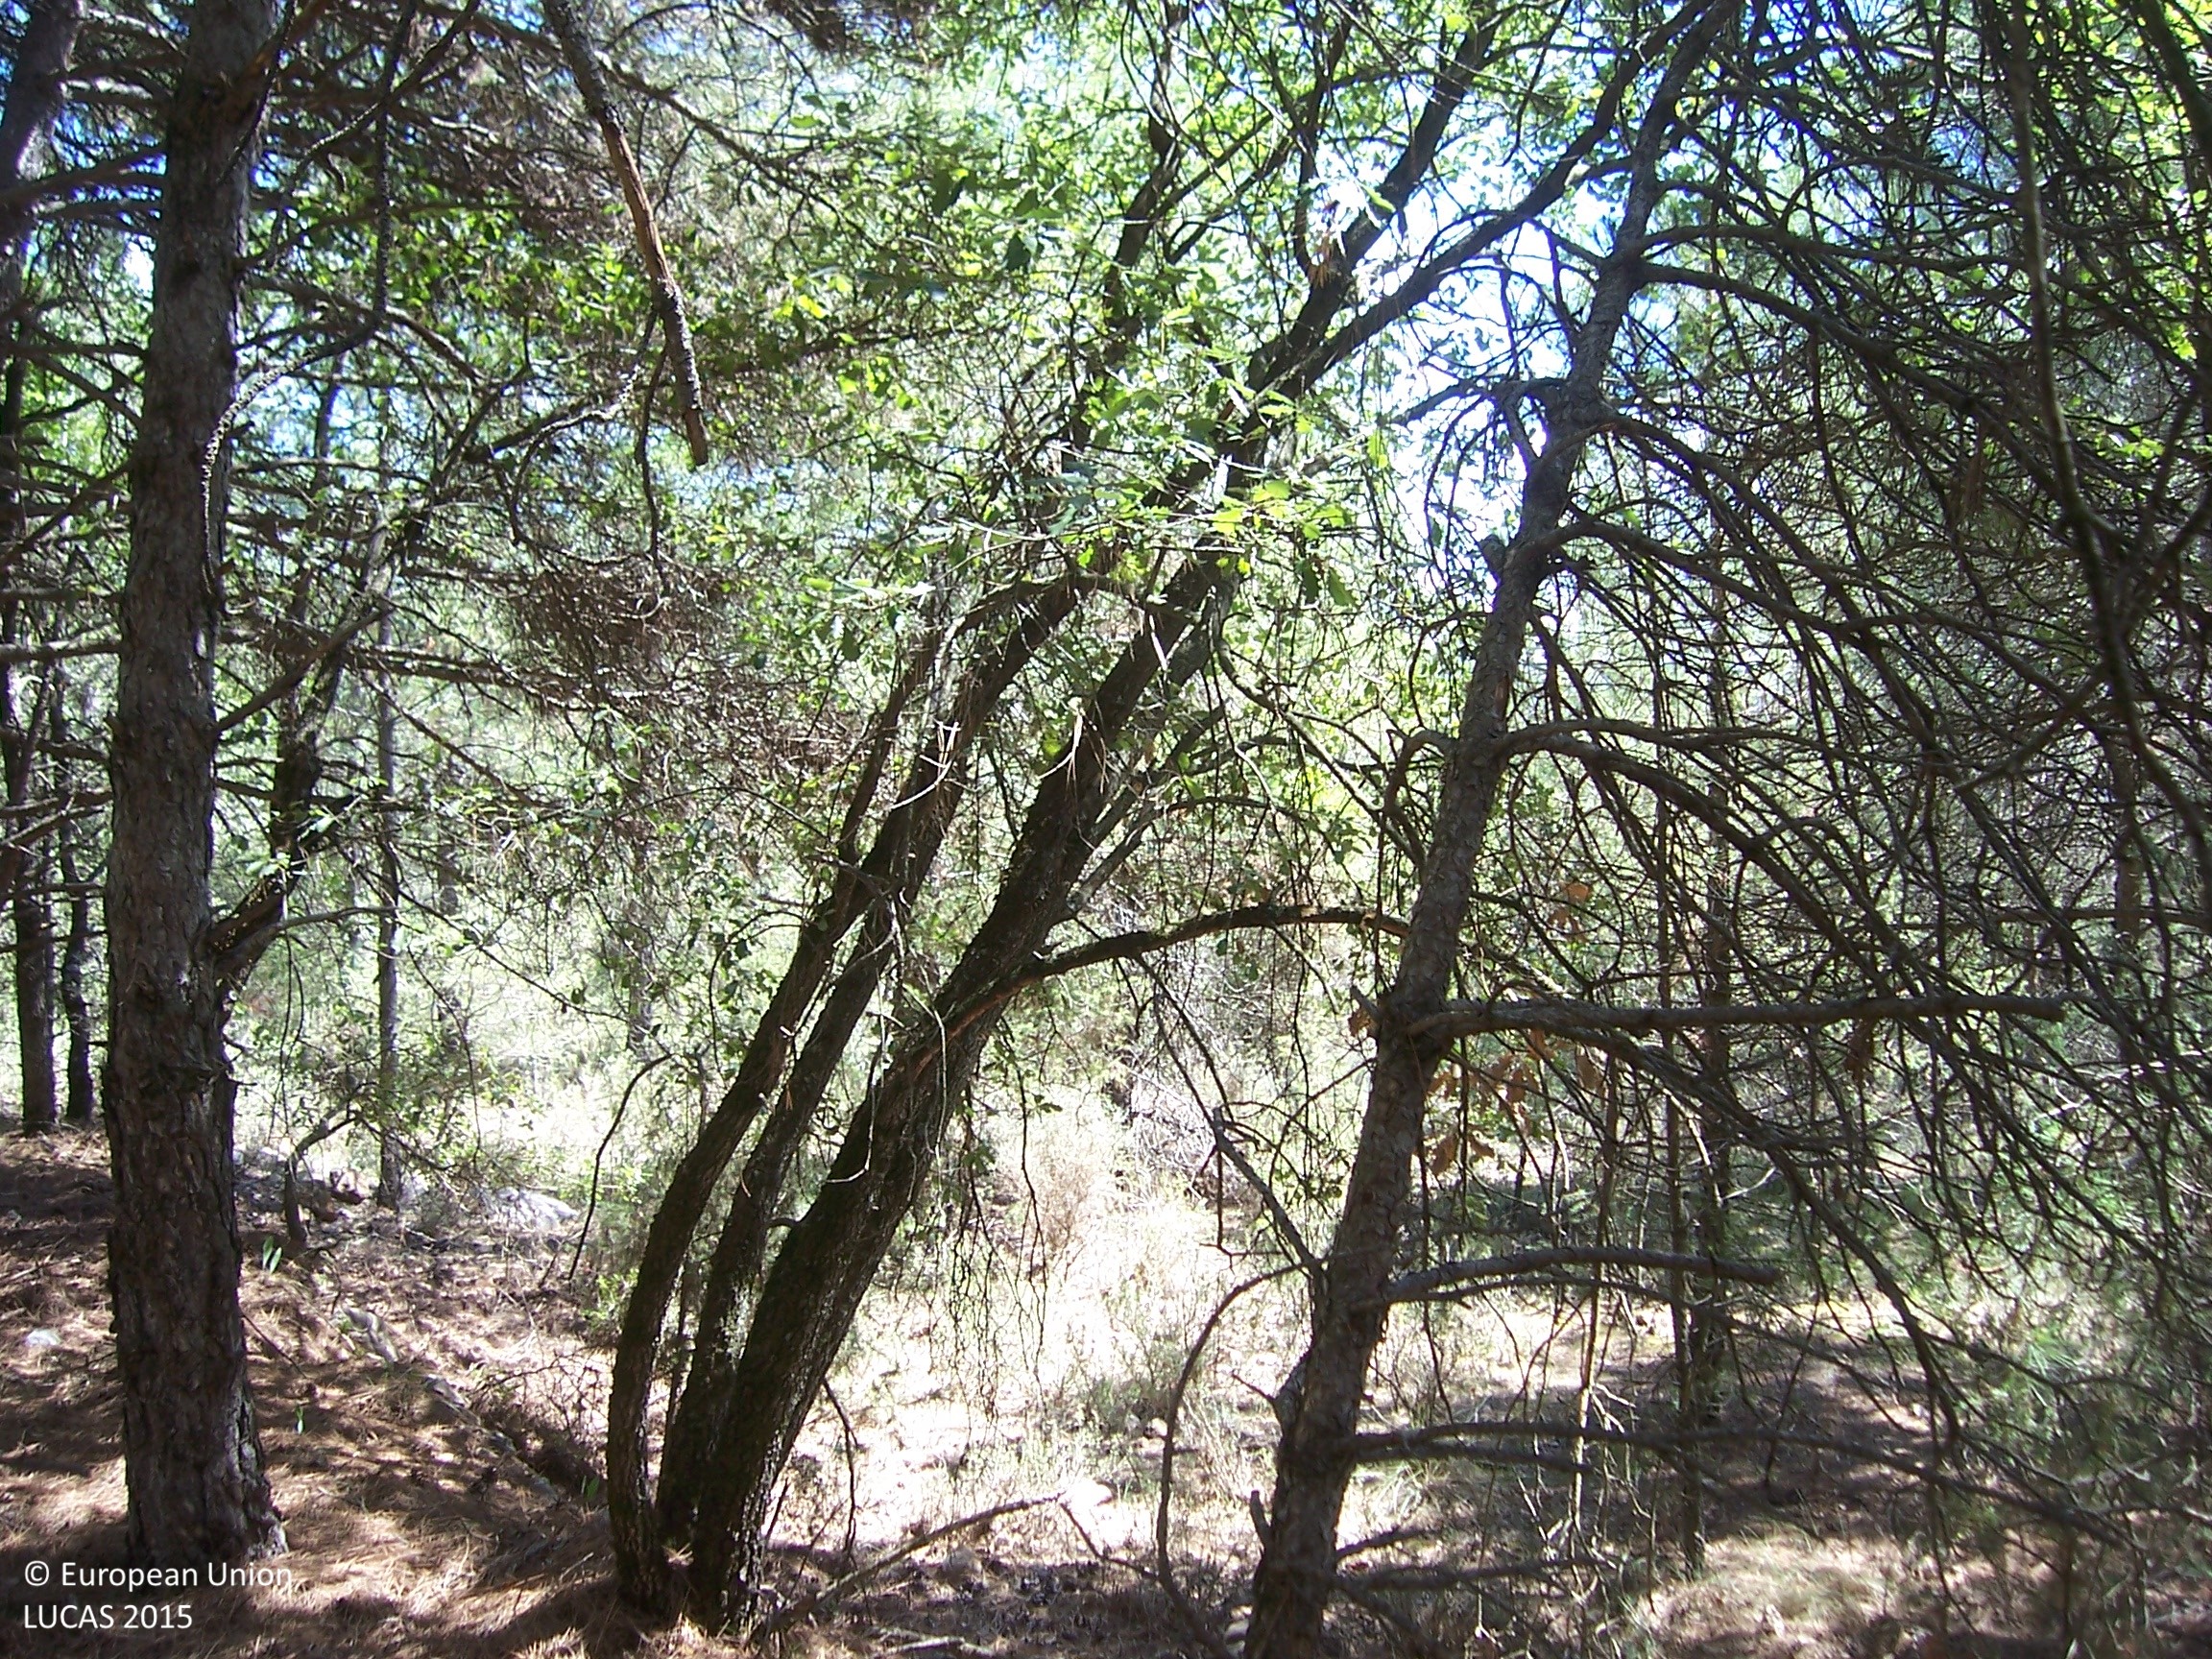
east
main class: Woodland
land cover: Pine dominated coniferous woodland
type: coniferous forest of the mediterranean region
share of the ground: > 75 %
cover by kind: coniferous forest trees 100 %
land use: Forestry
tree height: > 5 m
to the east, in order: Pine dominated coniferous woodland; Broadleaved woodland; Pine dominated mixed woodland
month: August
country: ES
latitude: 42.3087
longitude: 0.2386
